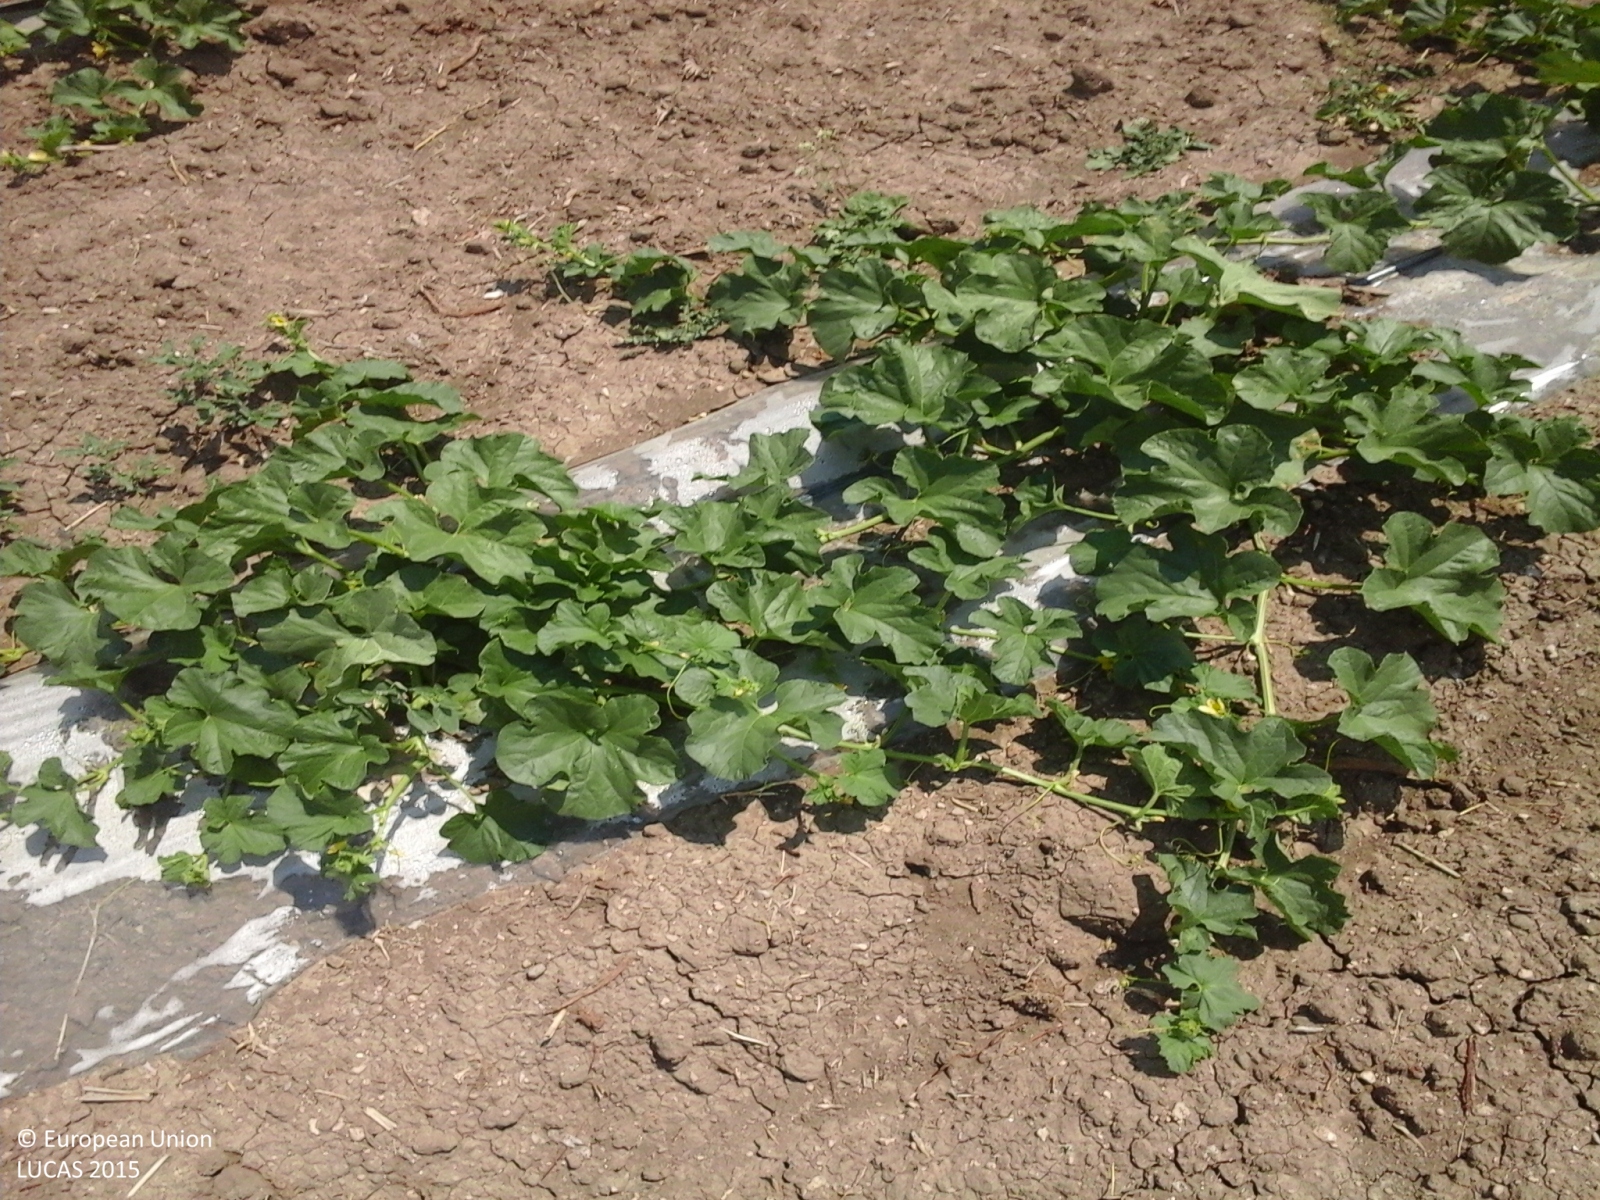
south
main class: Cropland
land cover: Other fresh vegetables
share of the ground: > 75 %
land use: Agriculture (excluding fallow land and kitchen gardens)
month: July
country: IT
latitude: 37.1904
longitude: 14.4156
